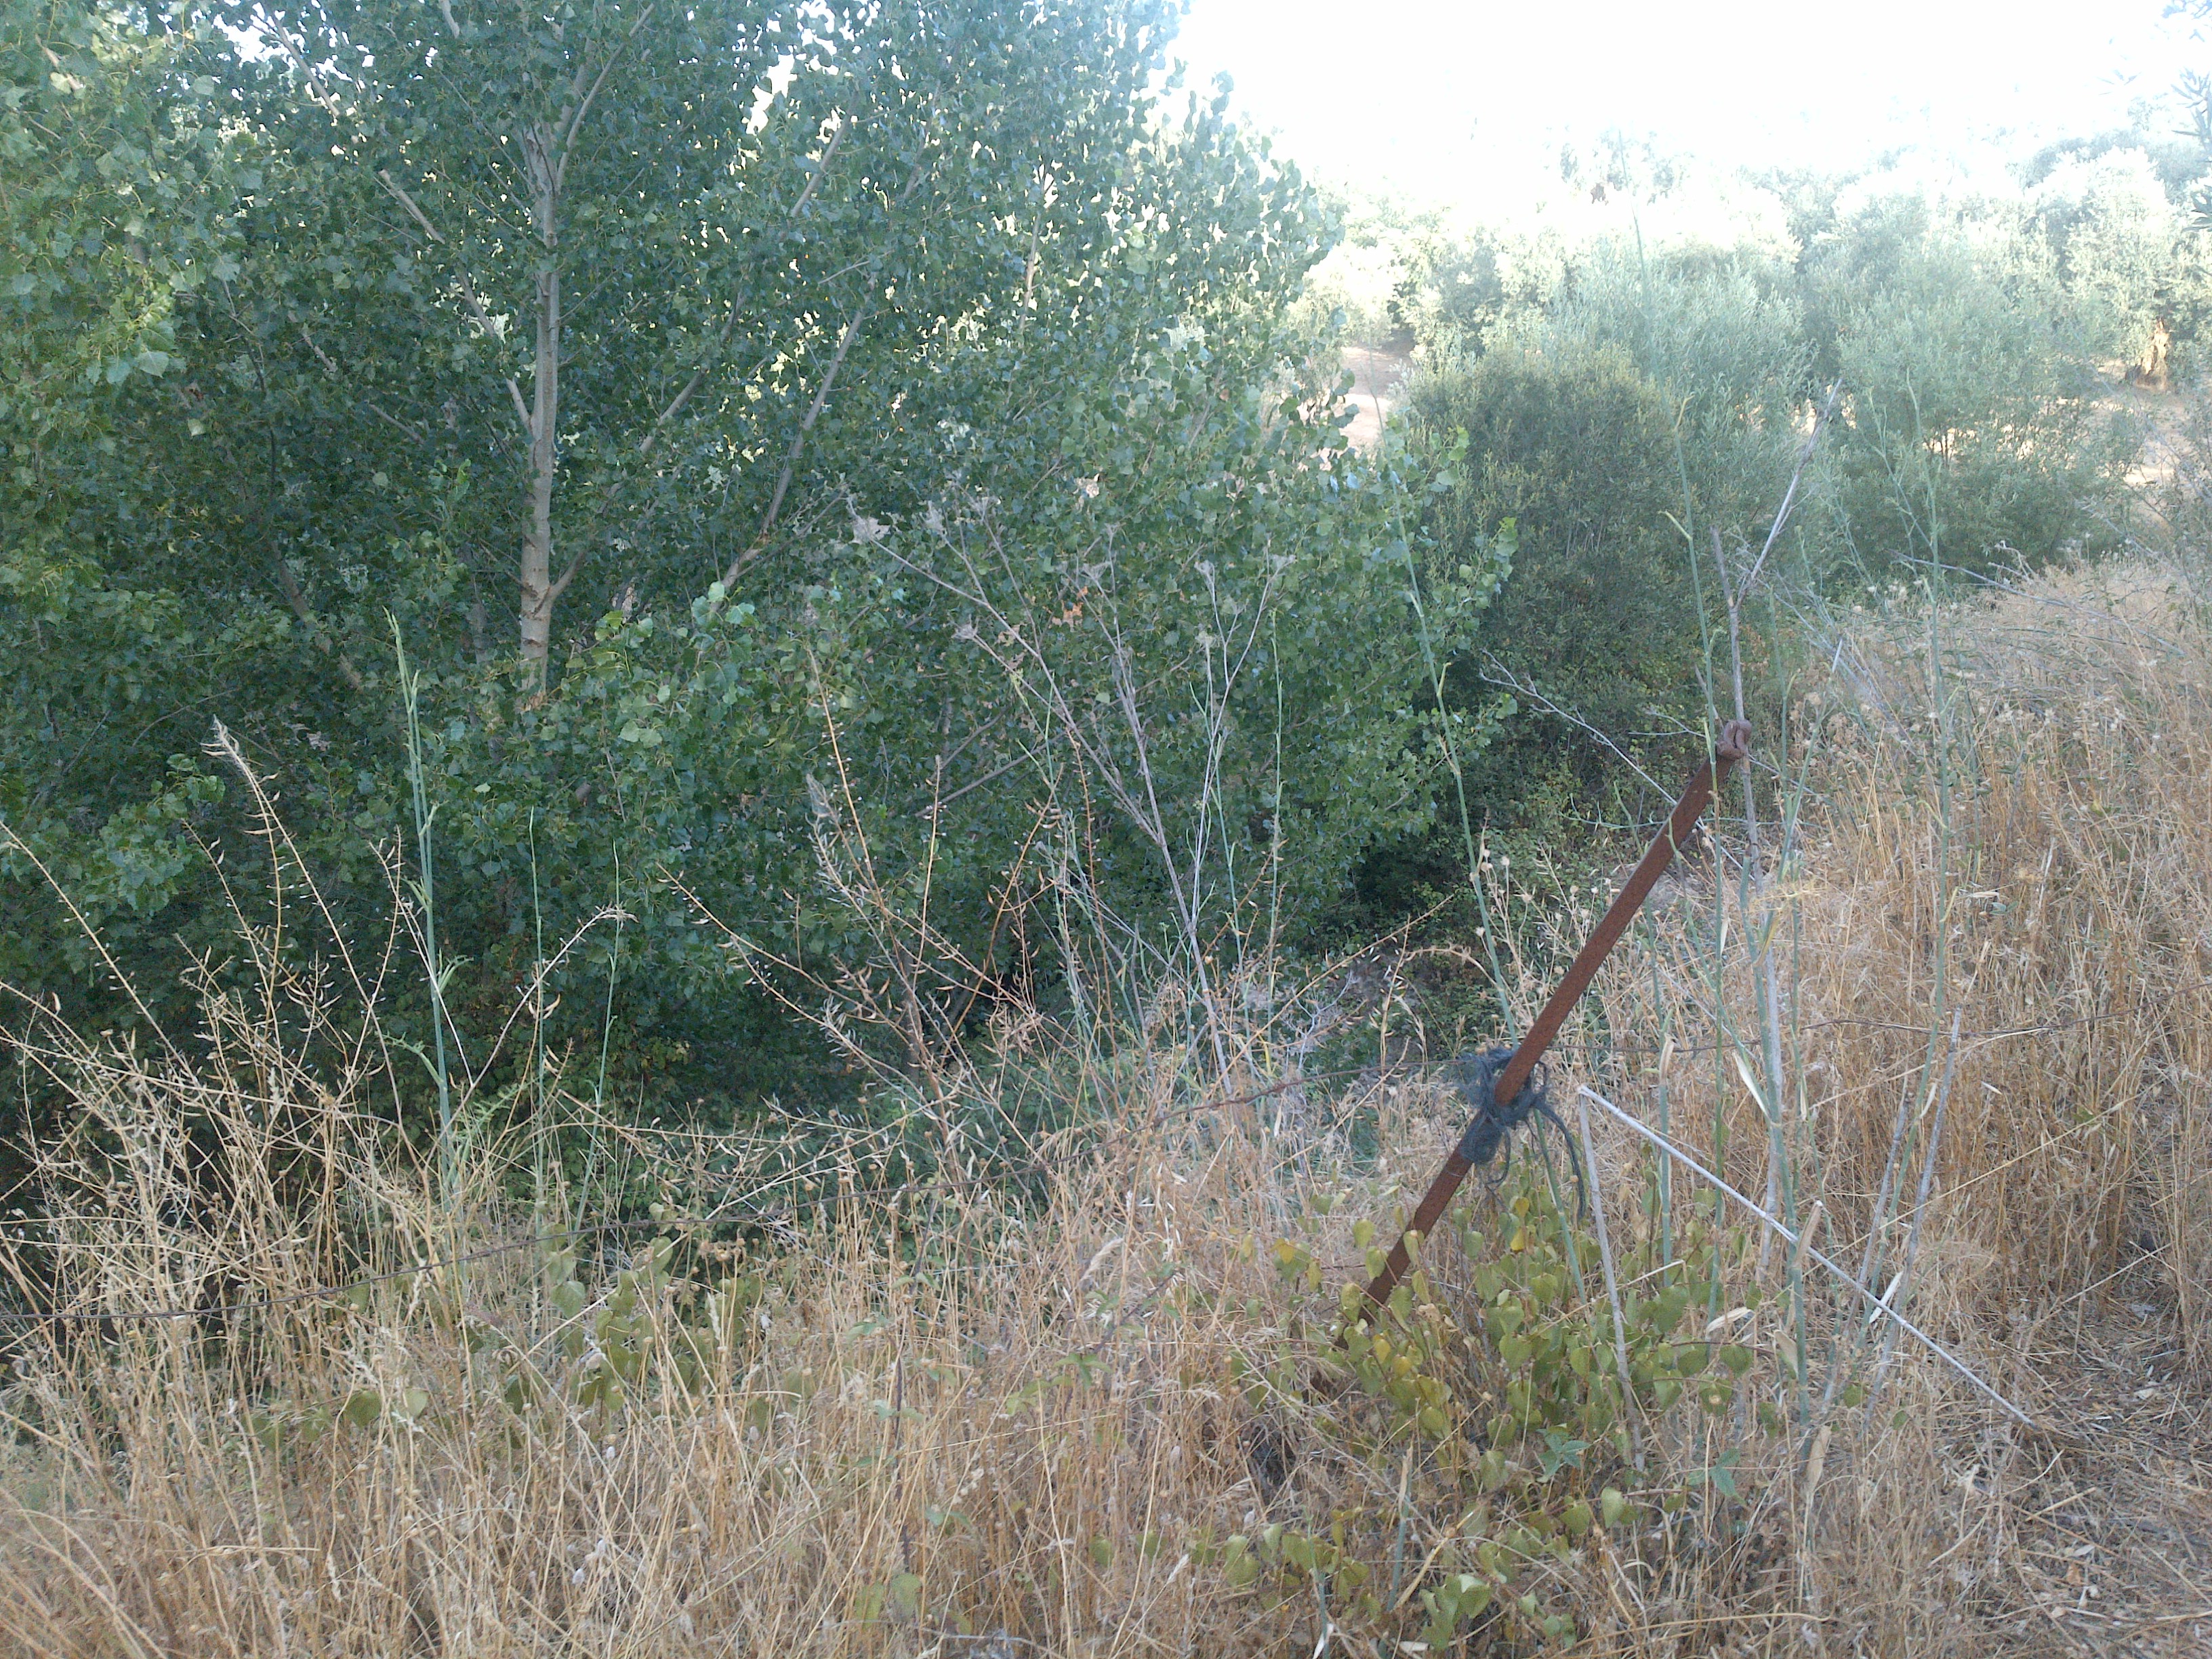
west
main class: Cropland
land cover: Olive groves
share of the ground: 50 - 75 %
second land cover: Spontaneously vegetated surfaces
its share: 10 - 25 %
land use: Agriculture (excluding fallow land and kitchen gardens)
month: July
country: ES
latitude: 37.3739
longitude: -4.4447
